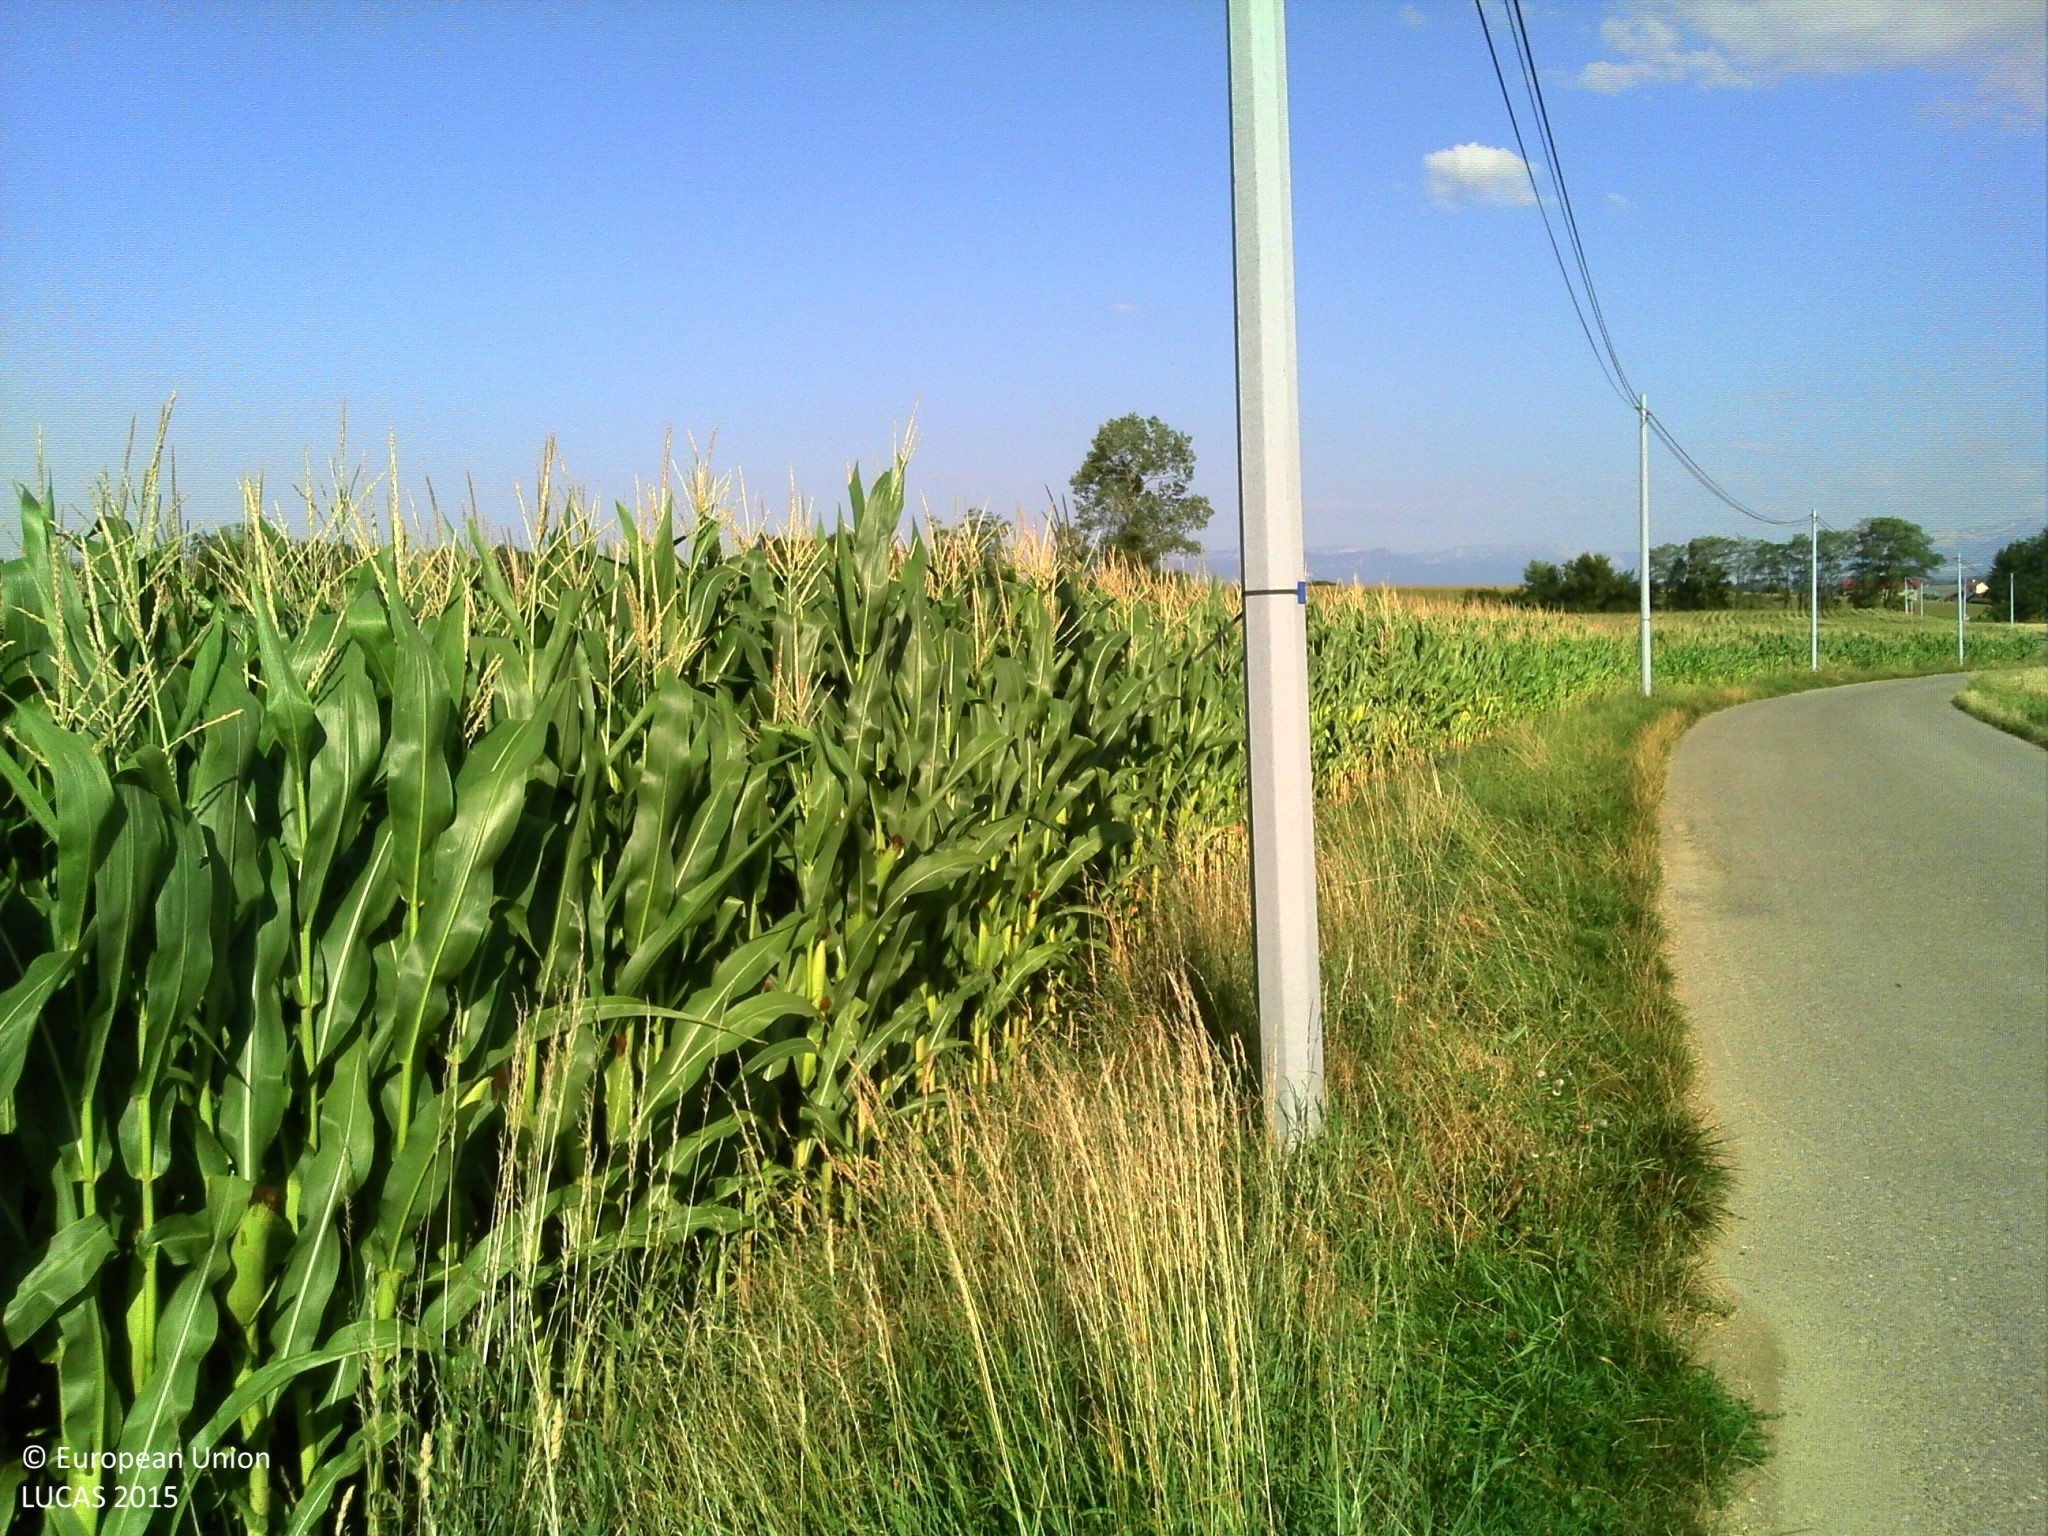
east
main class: Cropland
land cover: Maize
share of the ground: > 75 %
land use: Agriculture (excluding fallow land and kitchen gardens)
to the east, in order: Maize; Grassland without tree/shrub cover; Paved roads, cycling and walking lanes; Grass margins
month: August
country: FR
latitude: 45.5151
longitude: 5.4602
